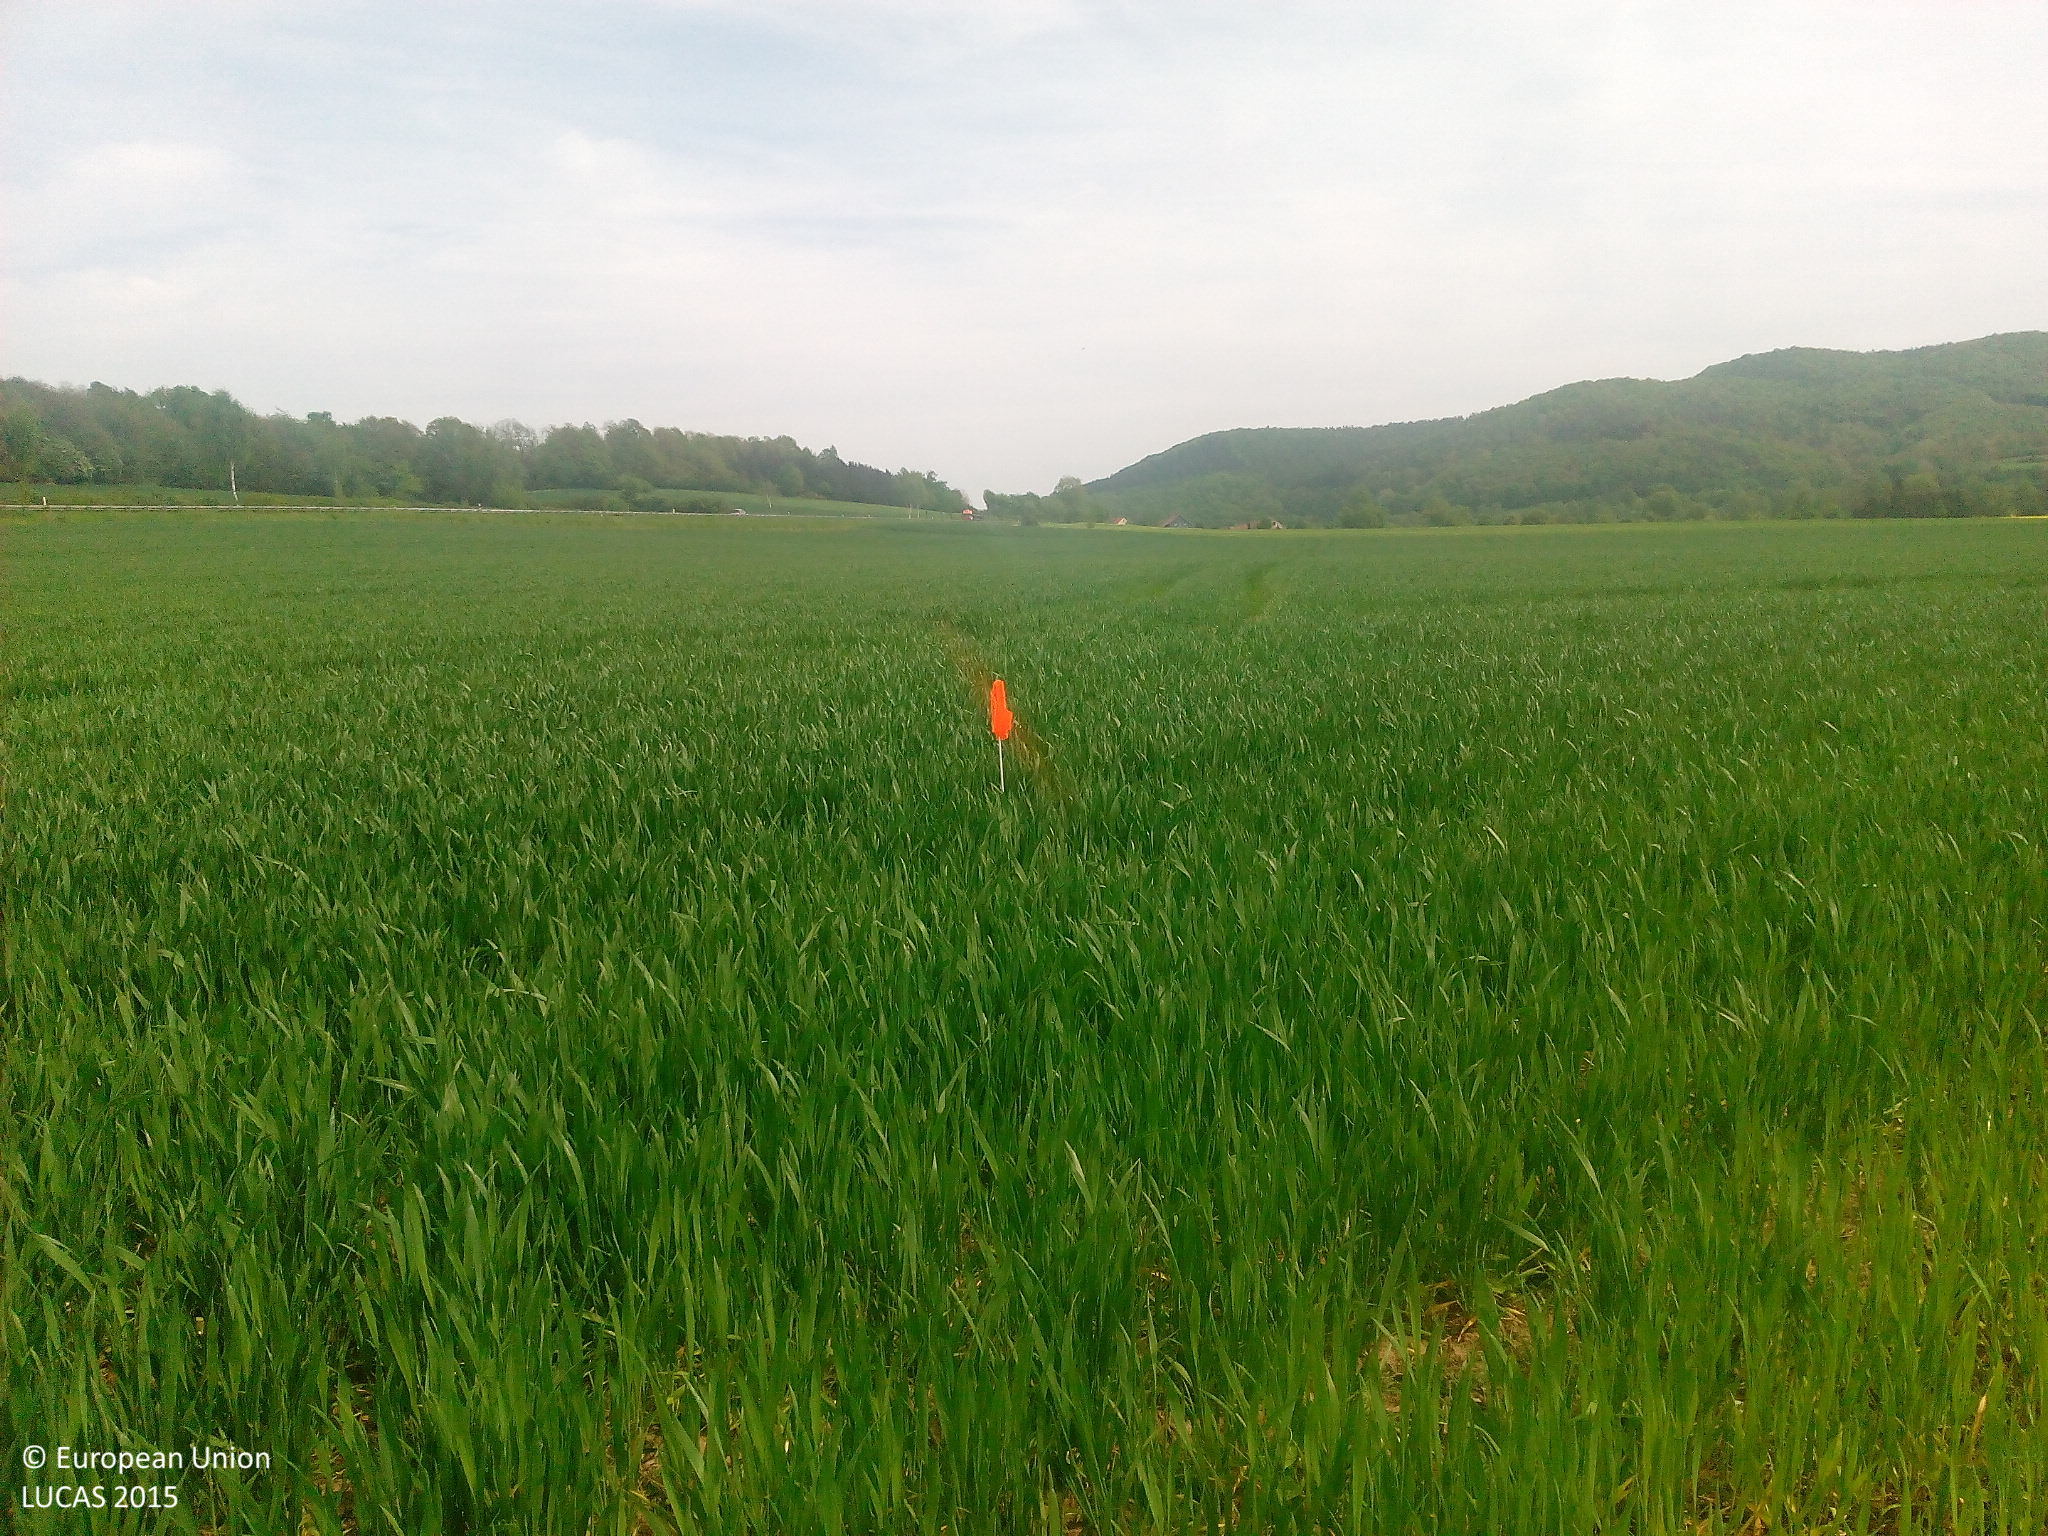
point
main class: Cropland
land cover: Common wheat
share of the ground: > 75 %
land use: Agriculture (excluding fallow land and kitchen gardens)
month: May
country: DE
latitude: 51.1371
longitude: 9.9571
